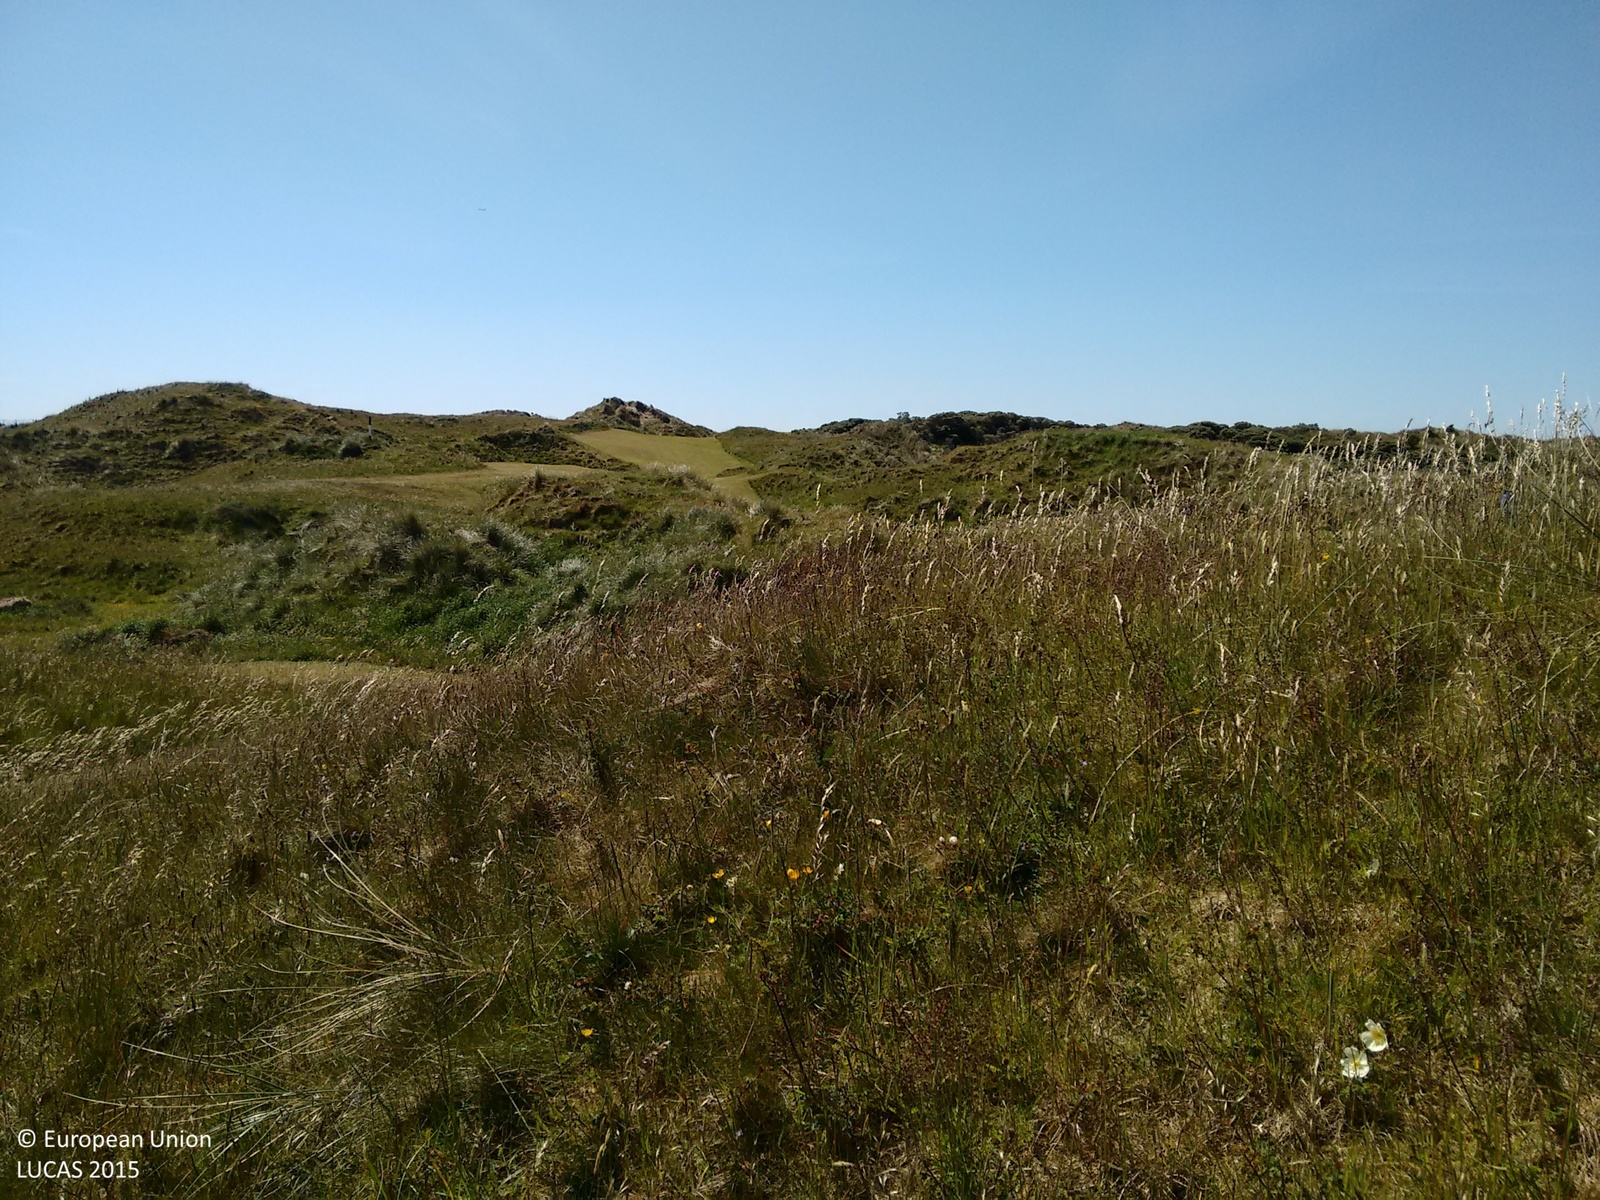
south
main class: Grassland
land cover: Grassland without tree/shrub cover
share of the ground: > 75 %
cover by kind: herbaceous plants 95 %, unconsolidated bare surface 5 %
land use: Sport
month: June
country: IE
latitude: 53.4670
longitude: -6.1287
